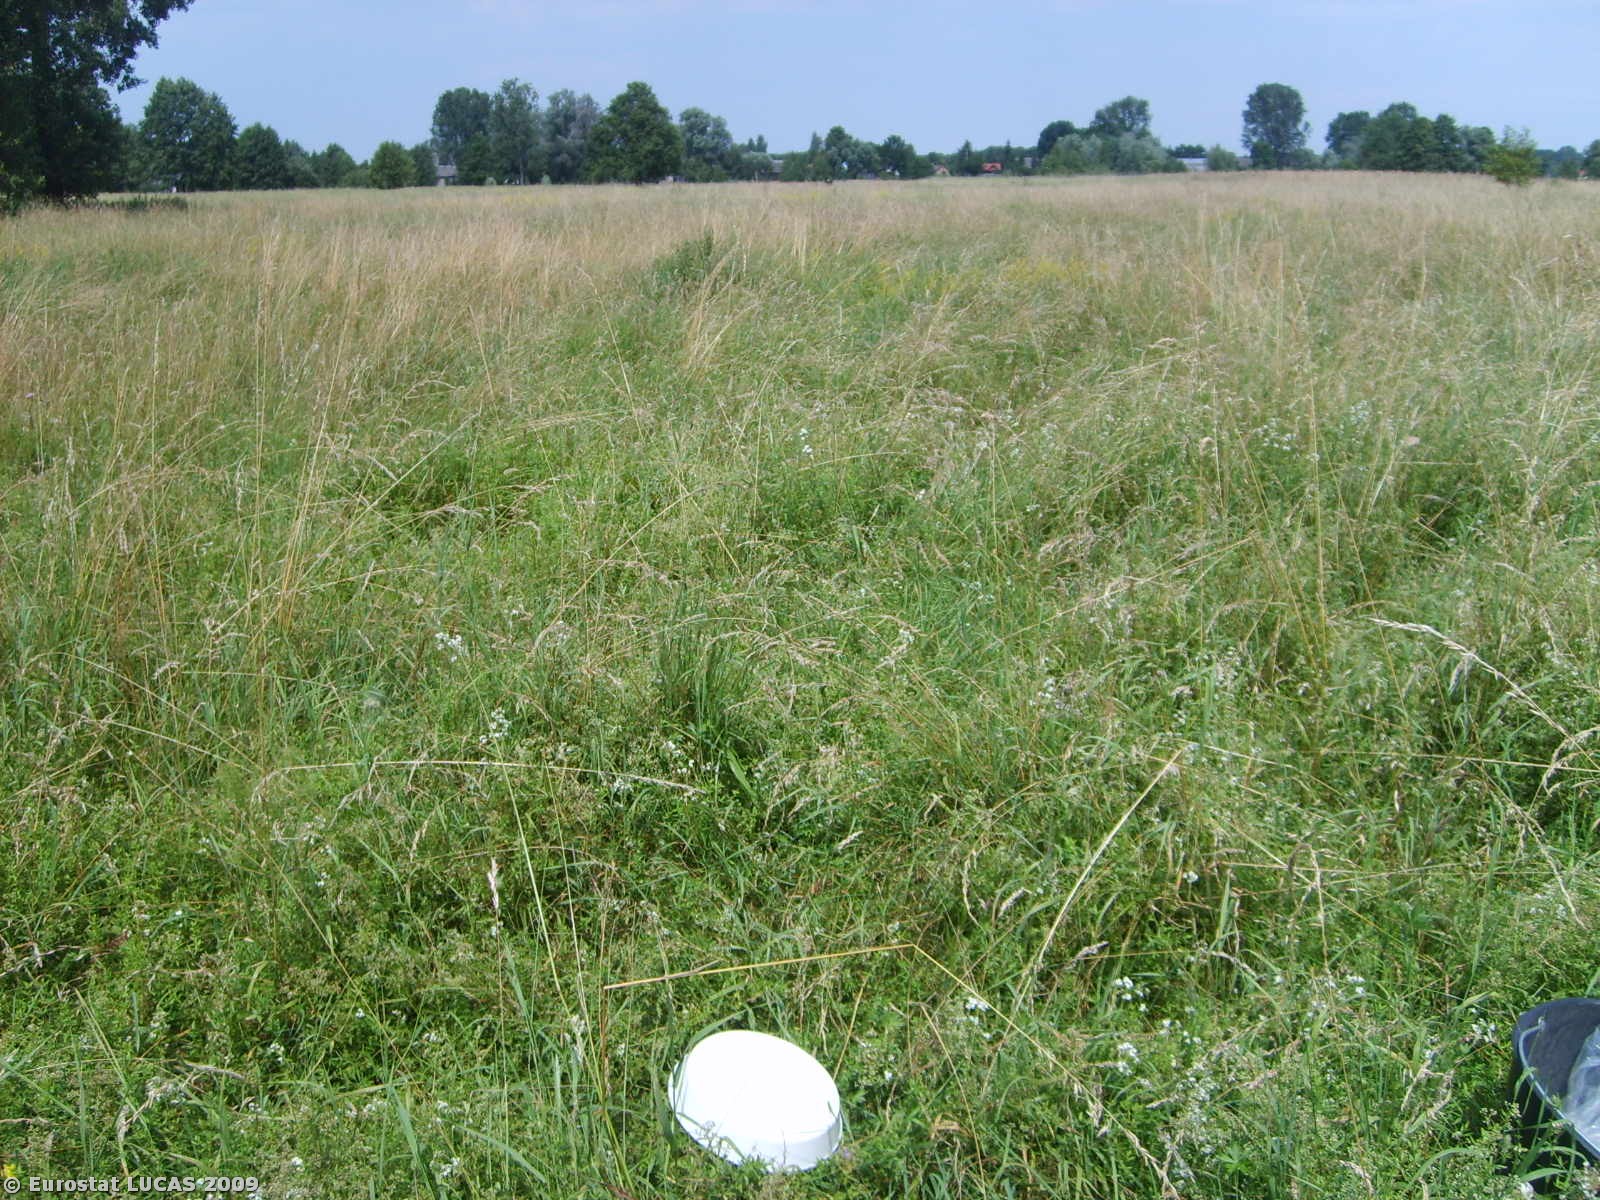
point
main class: Grassland
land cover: Grassland without tree/shrub cover
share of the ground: > 75 %
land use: Agriculture (excluding fallow land and kitchen gardens)
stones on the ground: < 10 %
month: July
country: PL
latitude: 52.5017
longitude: 21.7363
